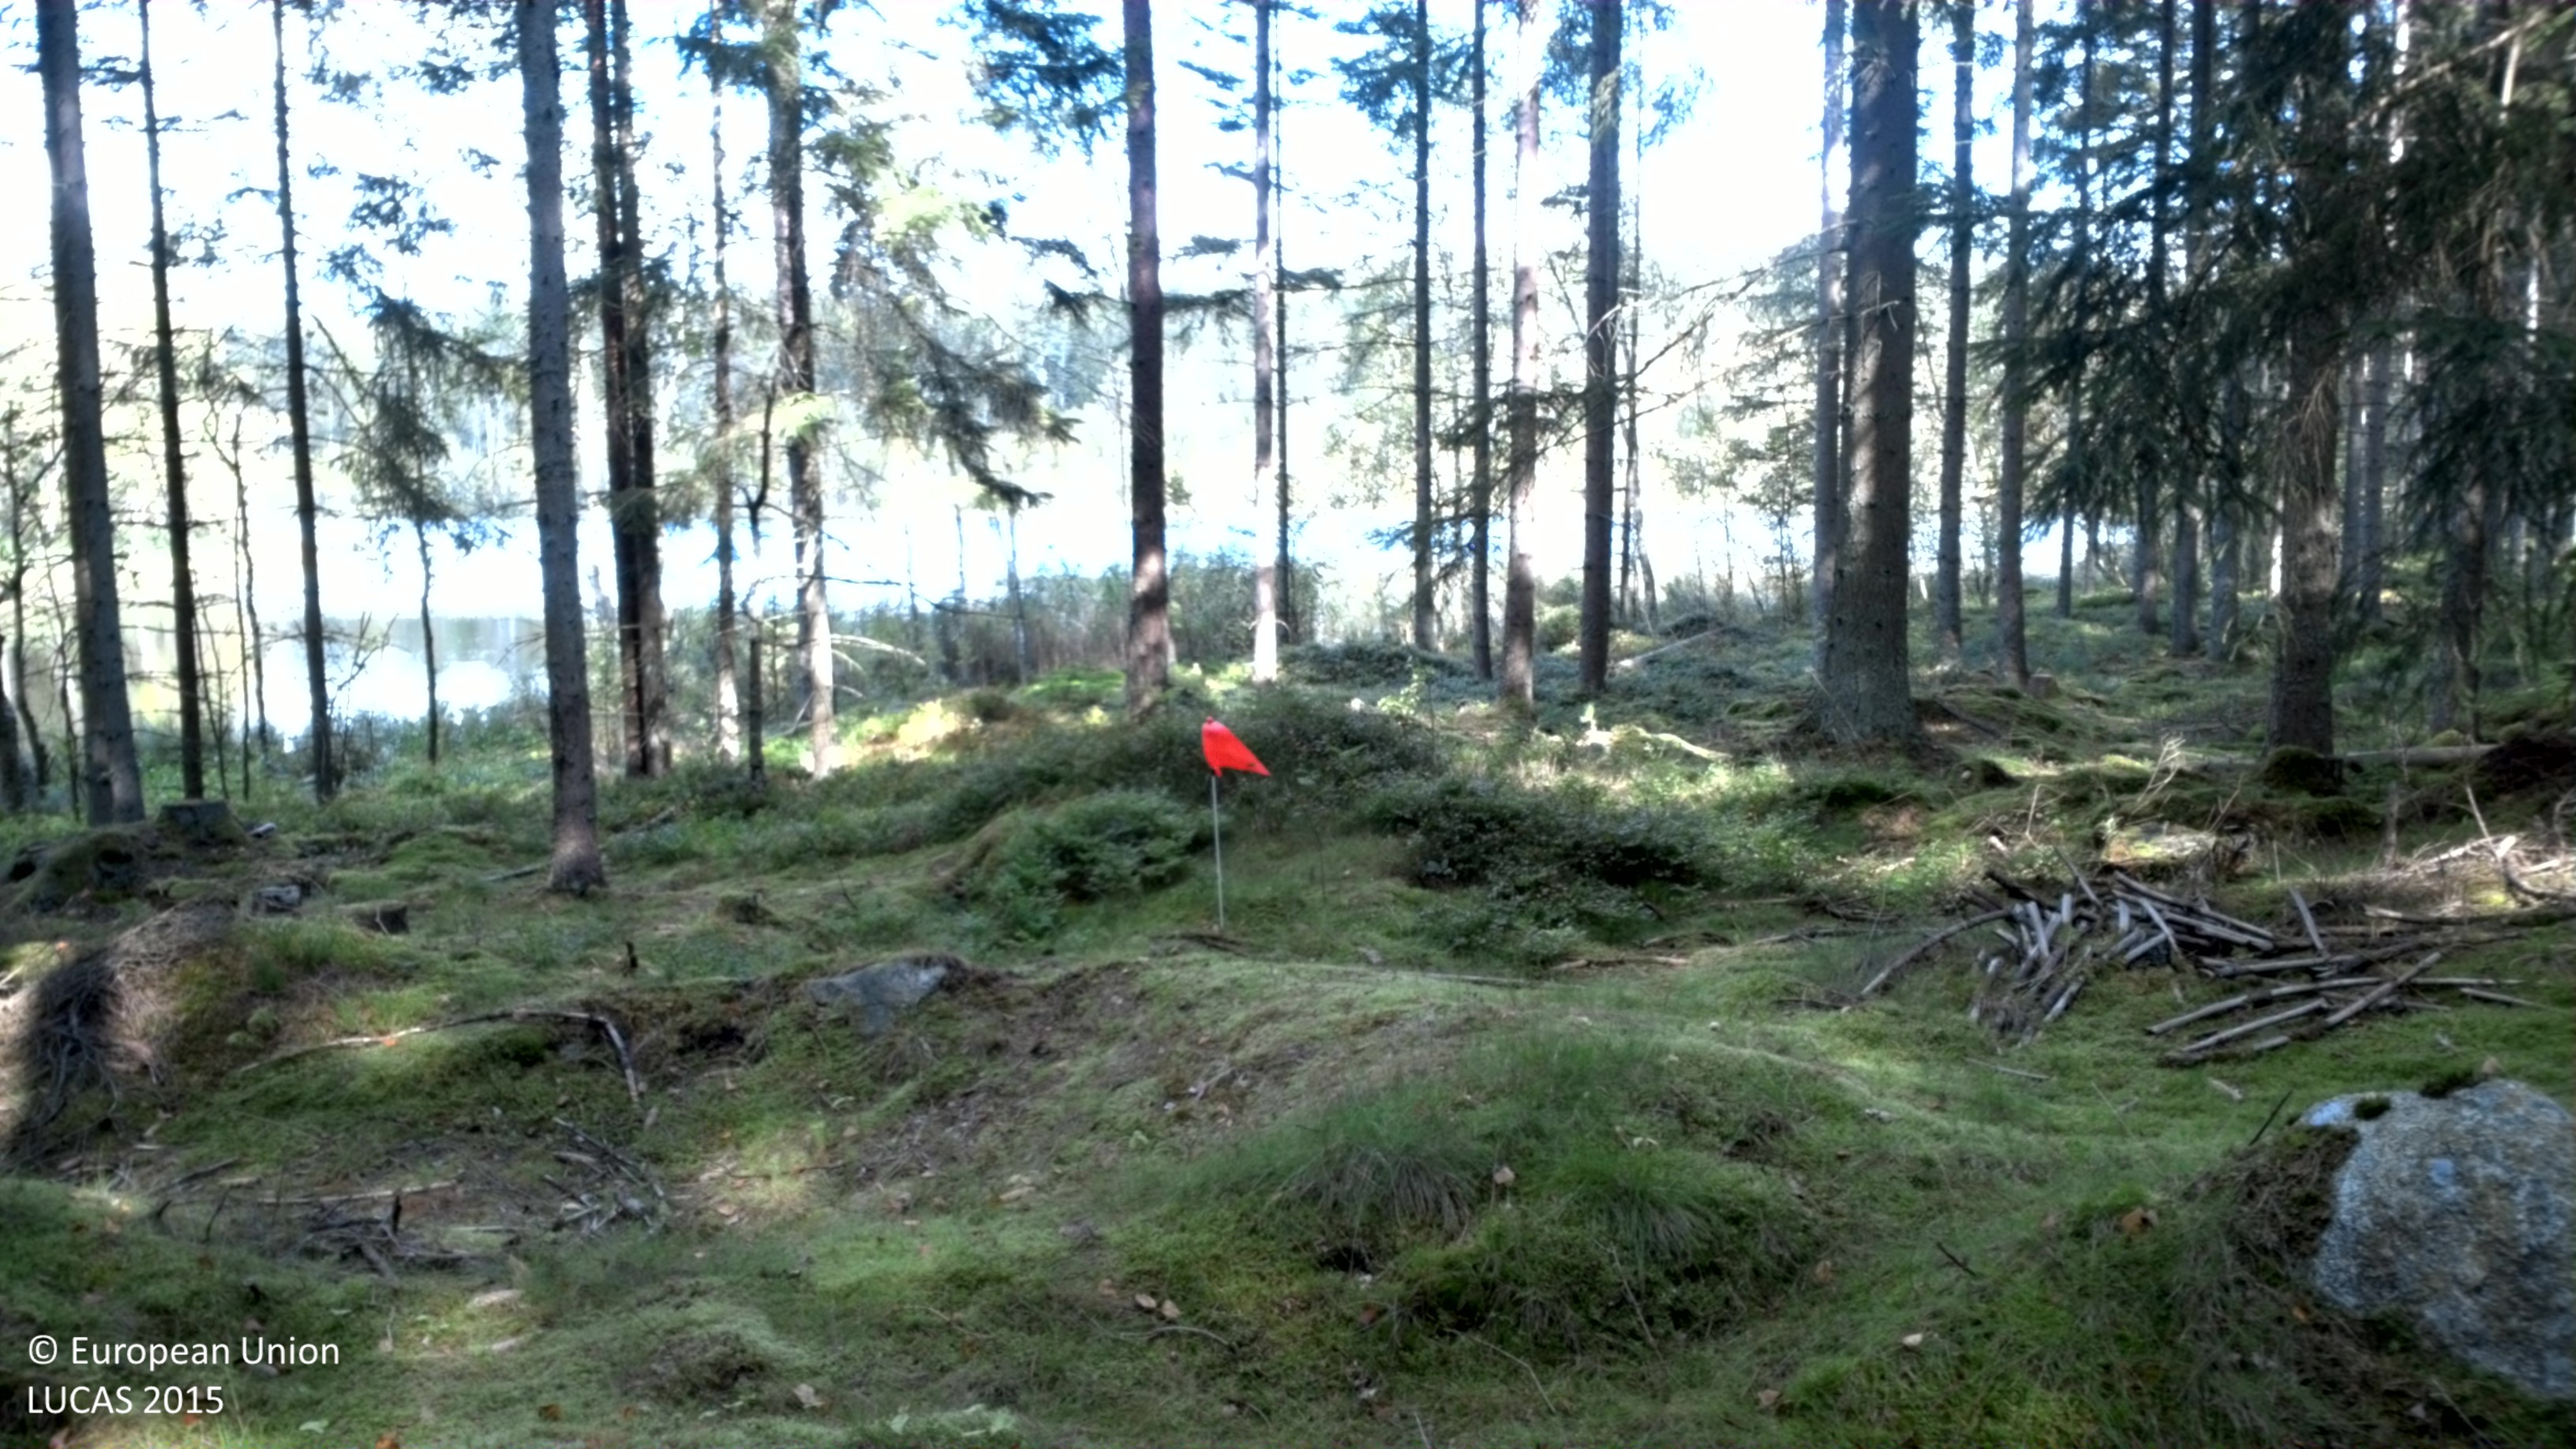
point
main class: Woodland
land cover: Spruce dominated coniferous woodland
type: boreal forest
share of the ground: > 75 %
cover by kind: coniferous forest trees 80 %, lichens and mosses 10 %, shrubs 5 %, herbaceous plants 5 %
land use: Forestry
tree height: > 5 m
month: August
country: SE
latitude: 56.2965
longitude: 14.2797
